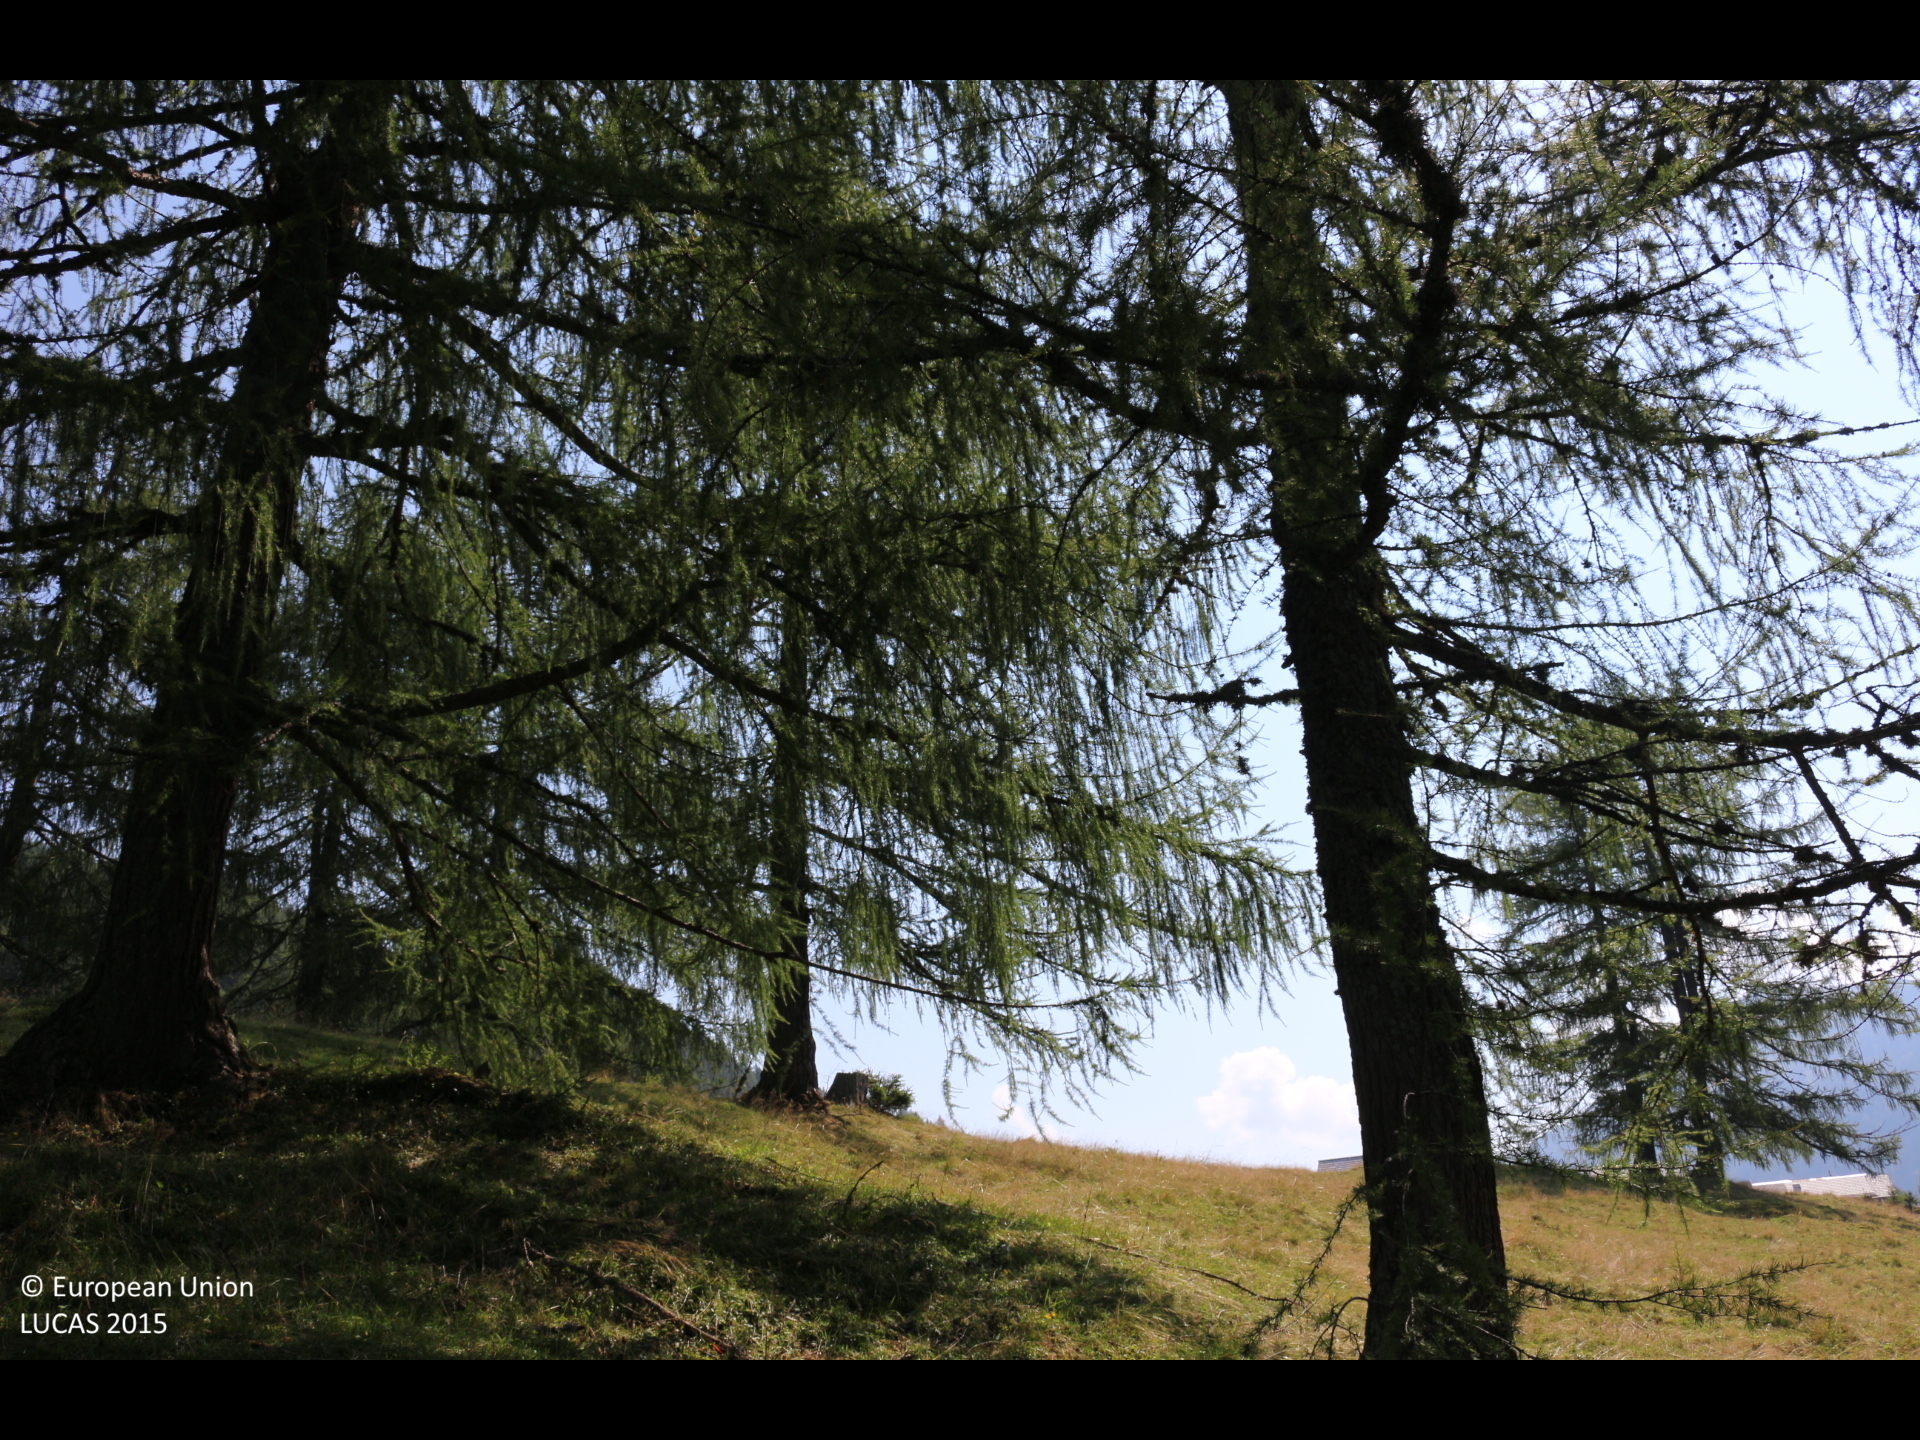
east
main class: Woodland
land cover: Other coniferous woodland
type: alpine coniferous forest
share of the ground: 50 - 75 %
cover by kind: coniferous forest trees 60 %, herbaceous plants 40 %
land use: Forestry
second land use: Agriculture (excluding fallow land and kitchen gardens)
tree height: > 5 m
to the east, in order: Other coniferous woodland; Grassland with sparse tree/shrub cover; Spontaneously vegetated surfaces; Fences; Grassland without tree/shrub cover; Artificial constructions in urban areas
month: August
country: AT
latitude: 46.5863
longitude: 13.3773
